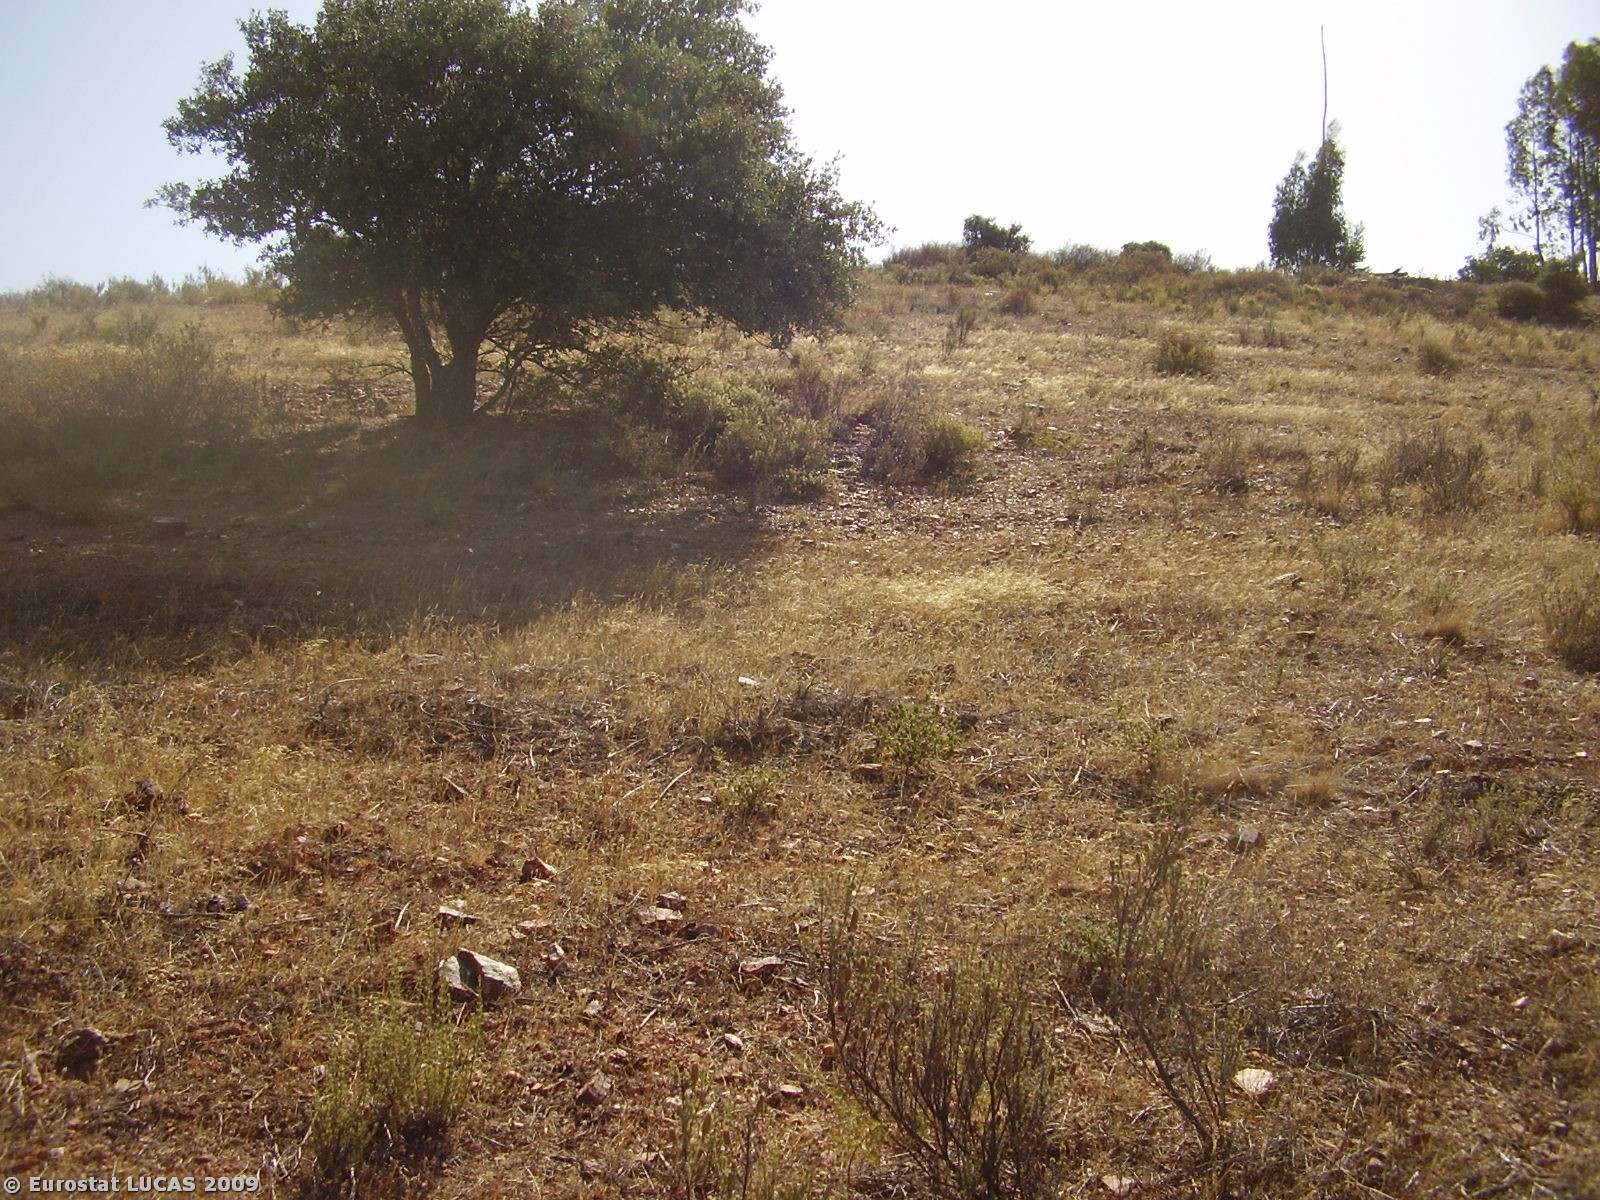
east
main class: Grassland
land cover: Grassland with sparse tree/shrub cover
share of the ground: > 75 %
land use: Fallow land
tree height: > 5 m
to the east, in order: Grassland with sparse tree/shrub cover; Single bushes/trees; Spontaneously vegetated surfaces; Rock outcrops; Spontaneously vegetated surfaces; Tracks; Broadleaved woodland; Spontaneously vegetated surfaces
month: July
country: PT
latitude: 37.7030
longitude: -7.4916
